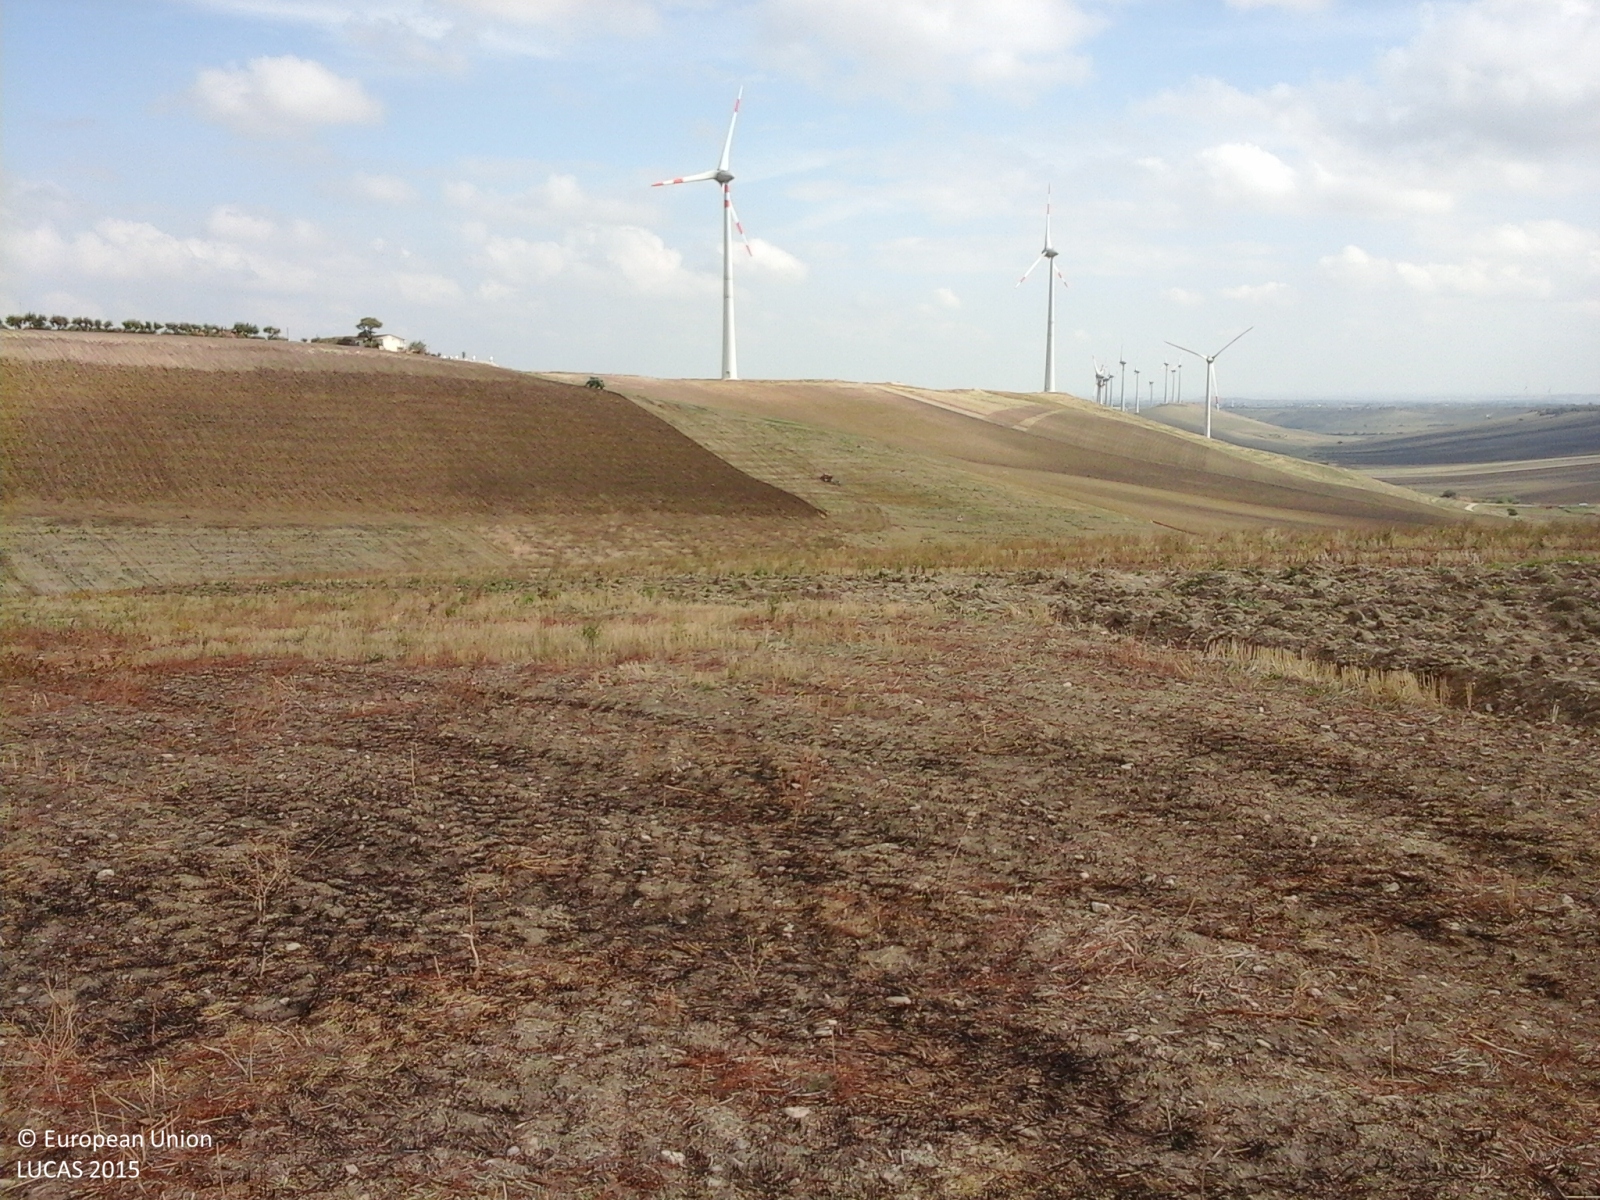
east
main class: Cropland
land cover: Durum wheat
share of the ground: > 75 %
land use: Agriculture (excluding fallow land and kitchen gardens)
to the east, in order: Durum wheat; Rape and turnip rape; Oats
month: October
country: IT
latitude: 41.4710
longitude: 15.1912
